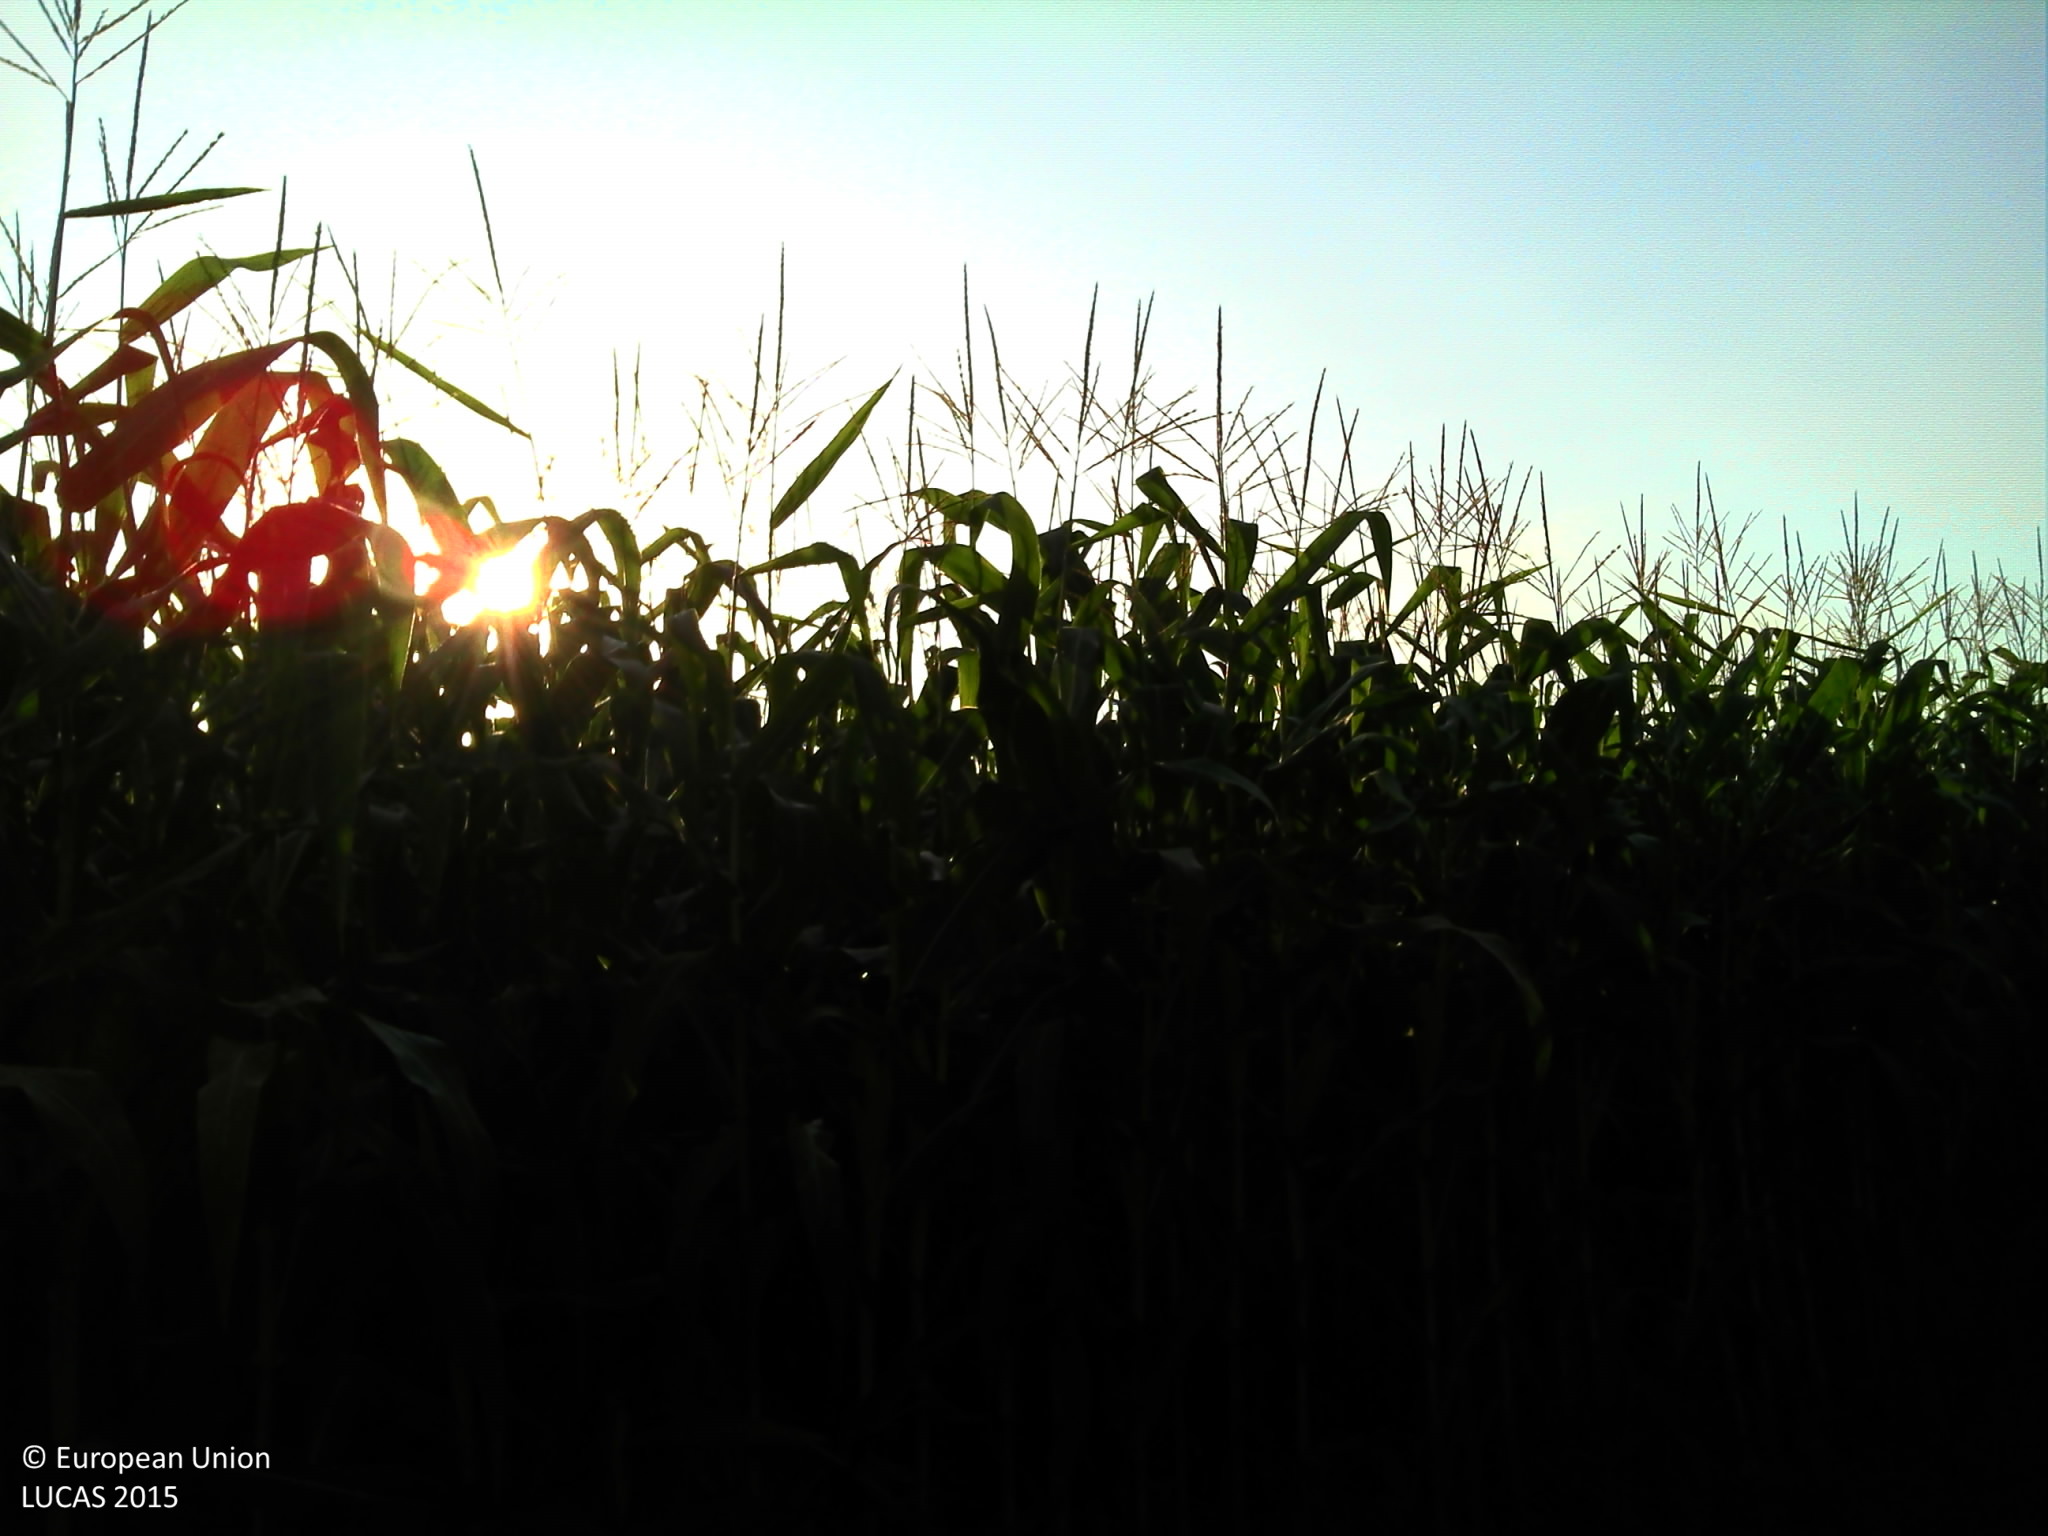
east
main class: Woodland
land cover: Broadleaved woodland
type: thermophilous deciduous forest
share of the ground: > 75 %
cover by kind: broadleaved forest trees 80 %, herbaceous plants 20 %
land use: Forestry
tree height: > 5 m
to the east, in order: Broadleaved woodland; Grass margins; Tracks; Maize; Single bushes/trees
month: August
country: FR
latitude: 44.8250
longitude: 0.9505
